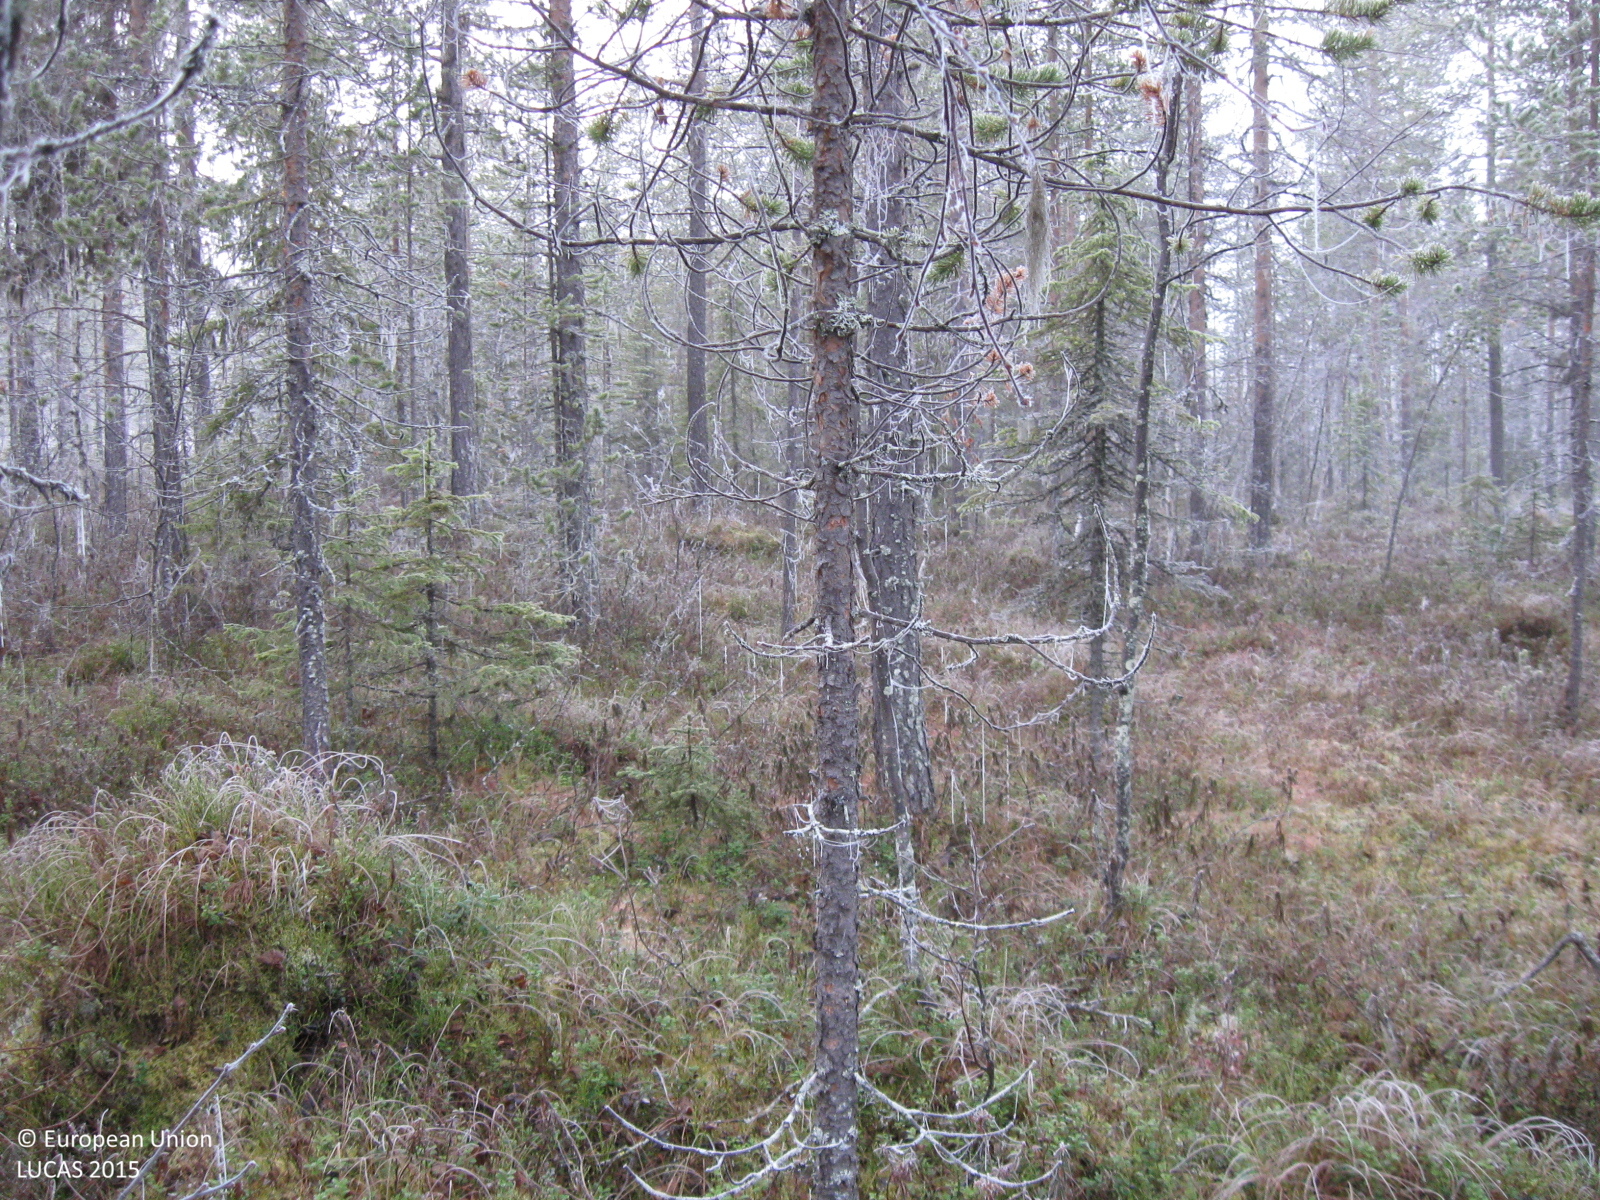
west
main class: Woodland
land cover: Pine dominated coniferous woodland
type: boreal forest
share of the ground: > 75 %
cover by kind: coniferous forest trees 60 %, broadleaved forest trees 15 %, shrubs 10 %, lichens and mosses 10 %, herbaceous plants 5 %
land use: Forestry
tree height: > 5 m
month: October
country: SE
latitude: 66.4168
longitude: 21.7250
